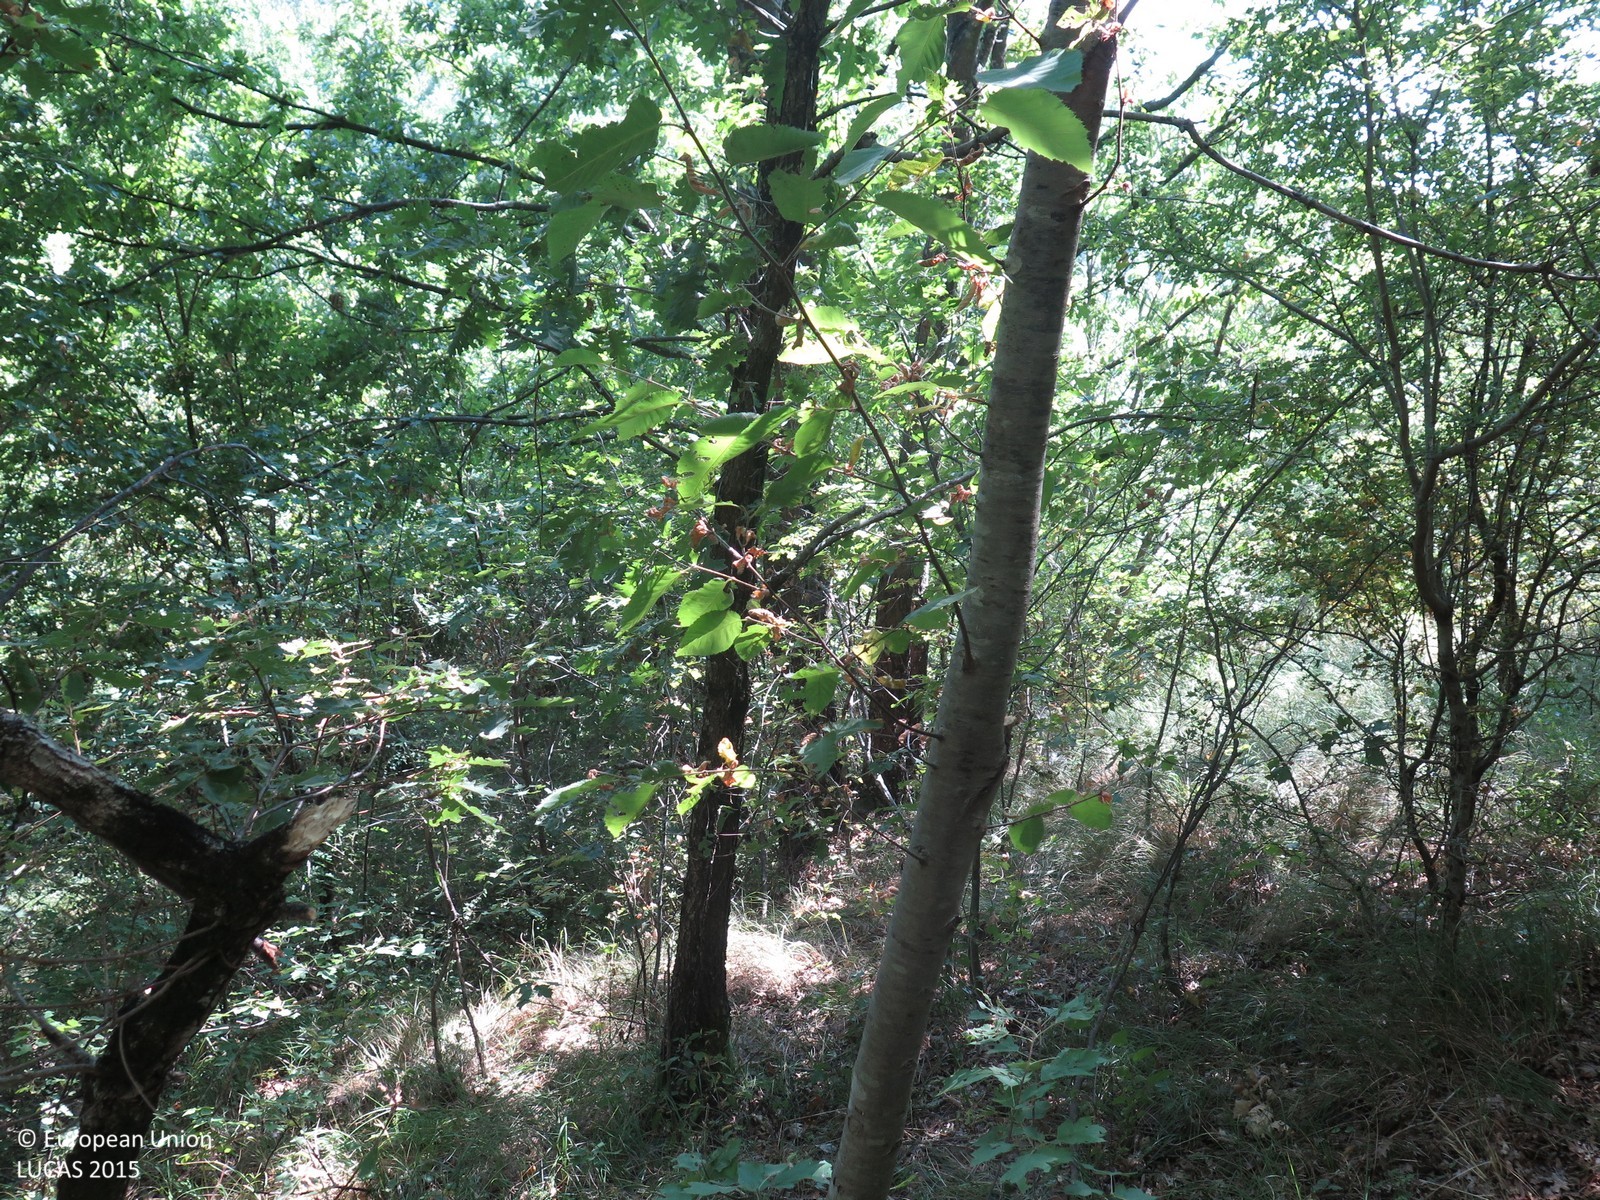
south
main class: Woodland
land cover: Broadleaved woodland
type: acidophilous oak and oak-birch forest
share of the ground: > 75 %
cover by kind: broadleaved forest trees 90 %, coniferous forest trees 5 %, herbaceous plants 5 %
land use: Semi-natural and natural areas not in use
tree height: > 5 m
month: July
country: HR
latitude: 45.4372
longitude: 13.7663
